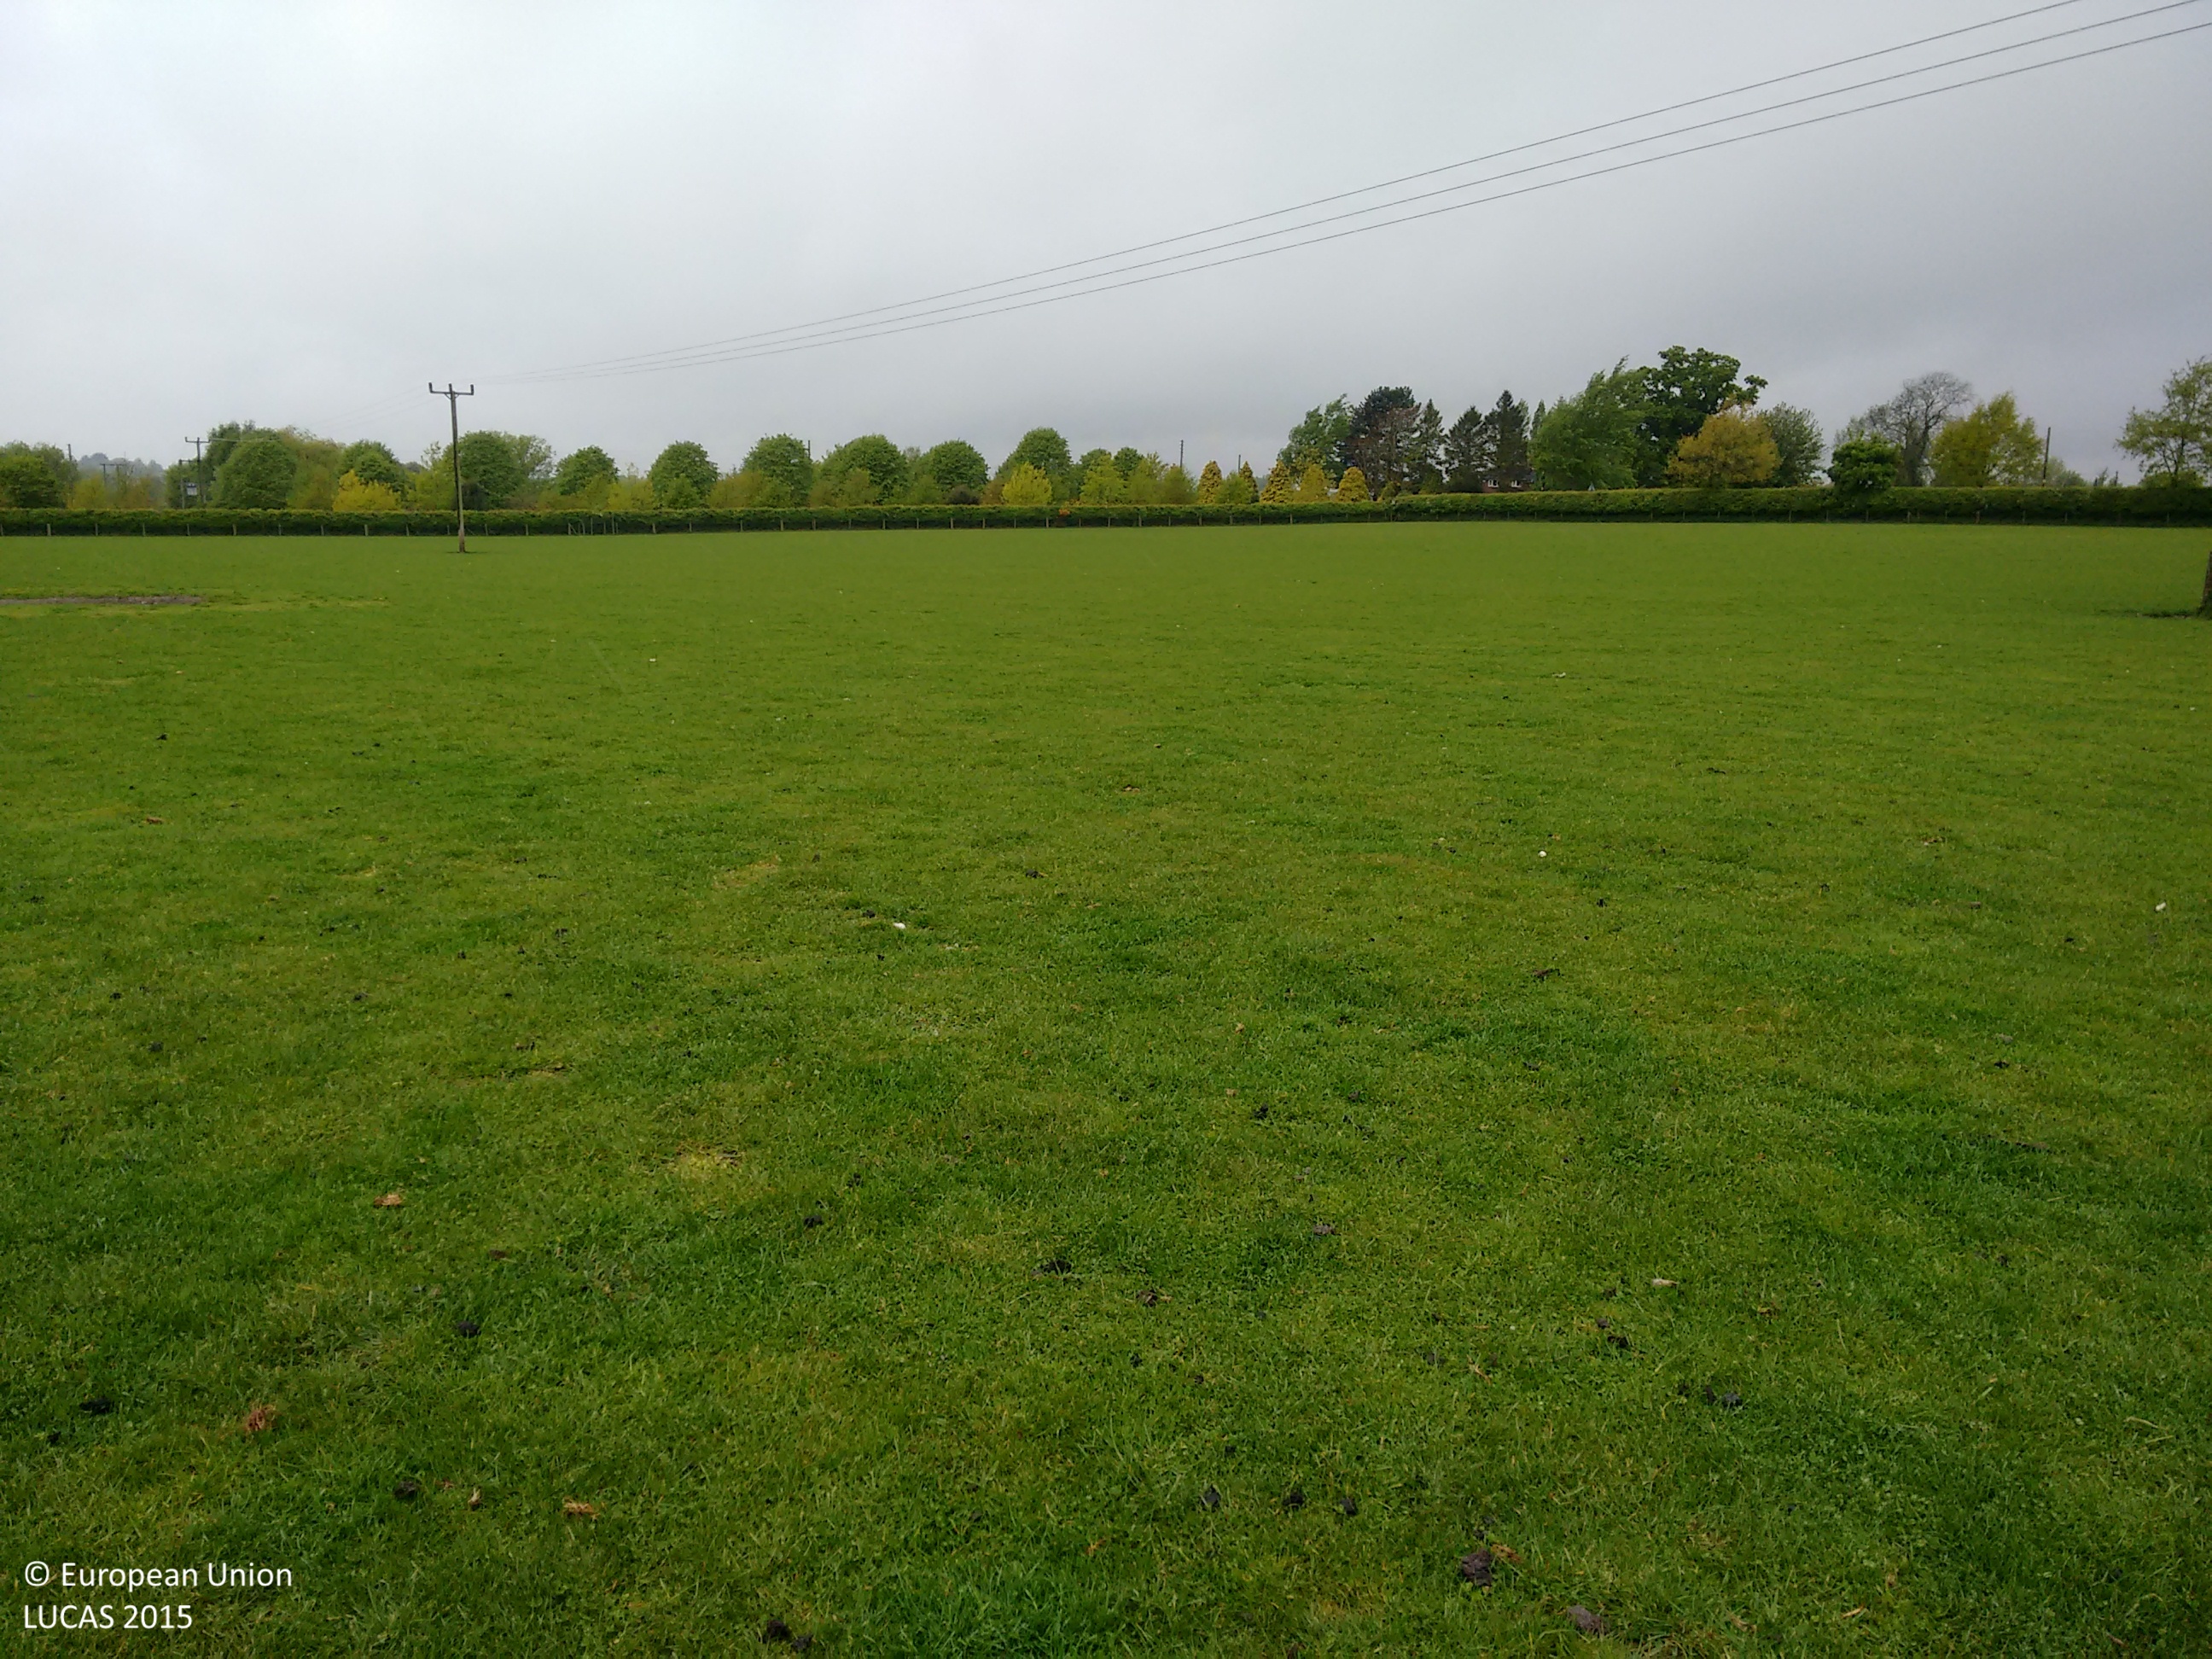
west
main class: Grassland
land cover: Grassland without tree/shrub cover
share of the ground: > 75 %
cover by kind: herbaceous plants 100 %
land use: Agriculture (excluding fallow land and kitchen gardens)
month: May
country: GB
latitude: 52.3708
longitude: -1.4032
